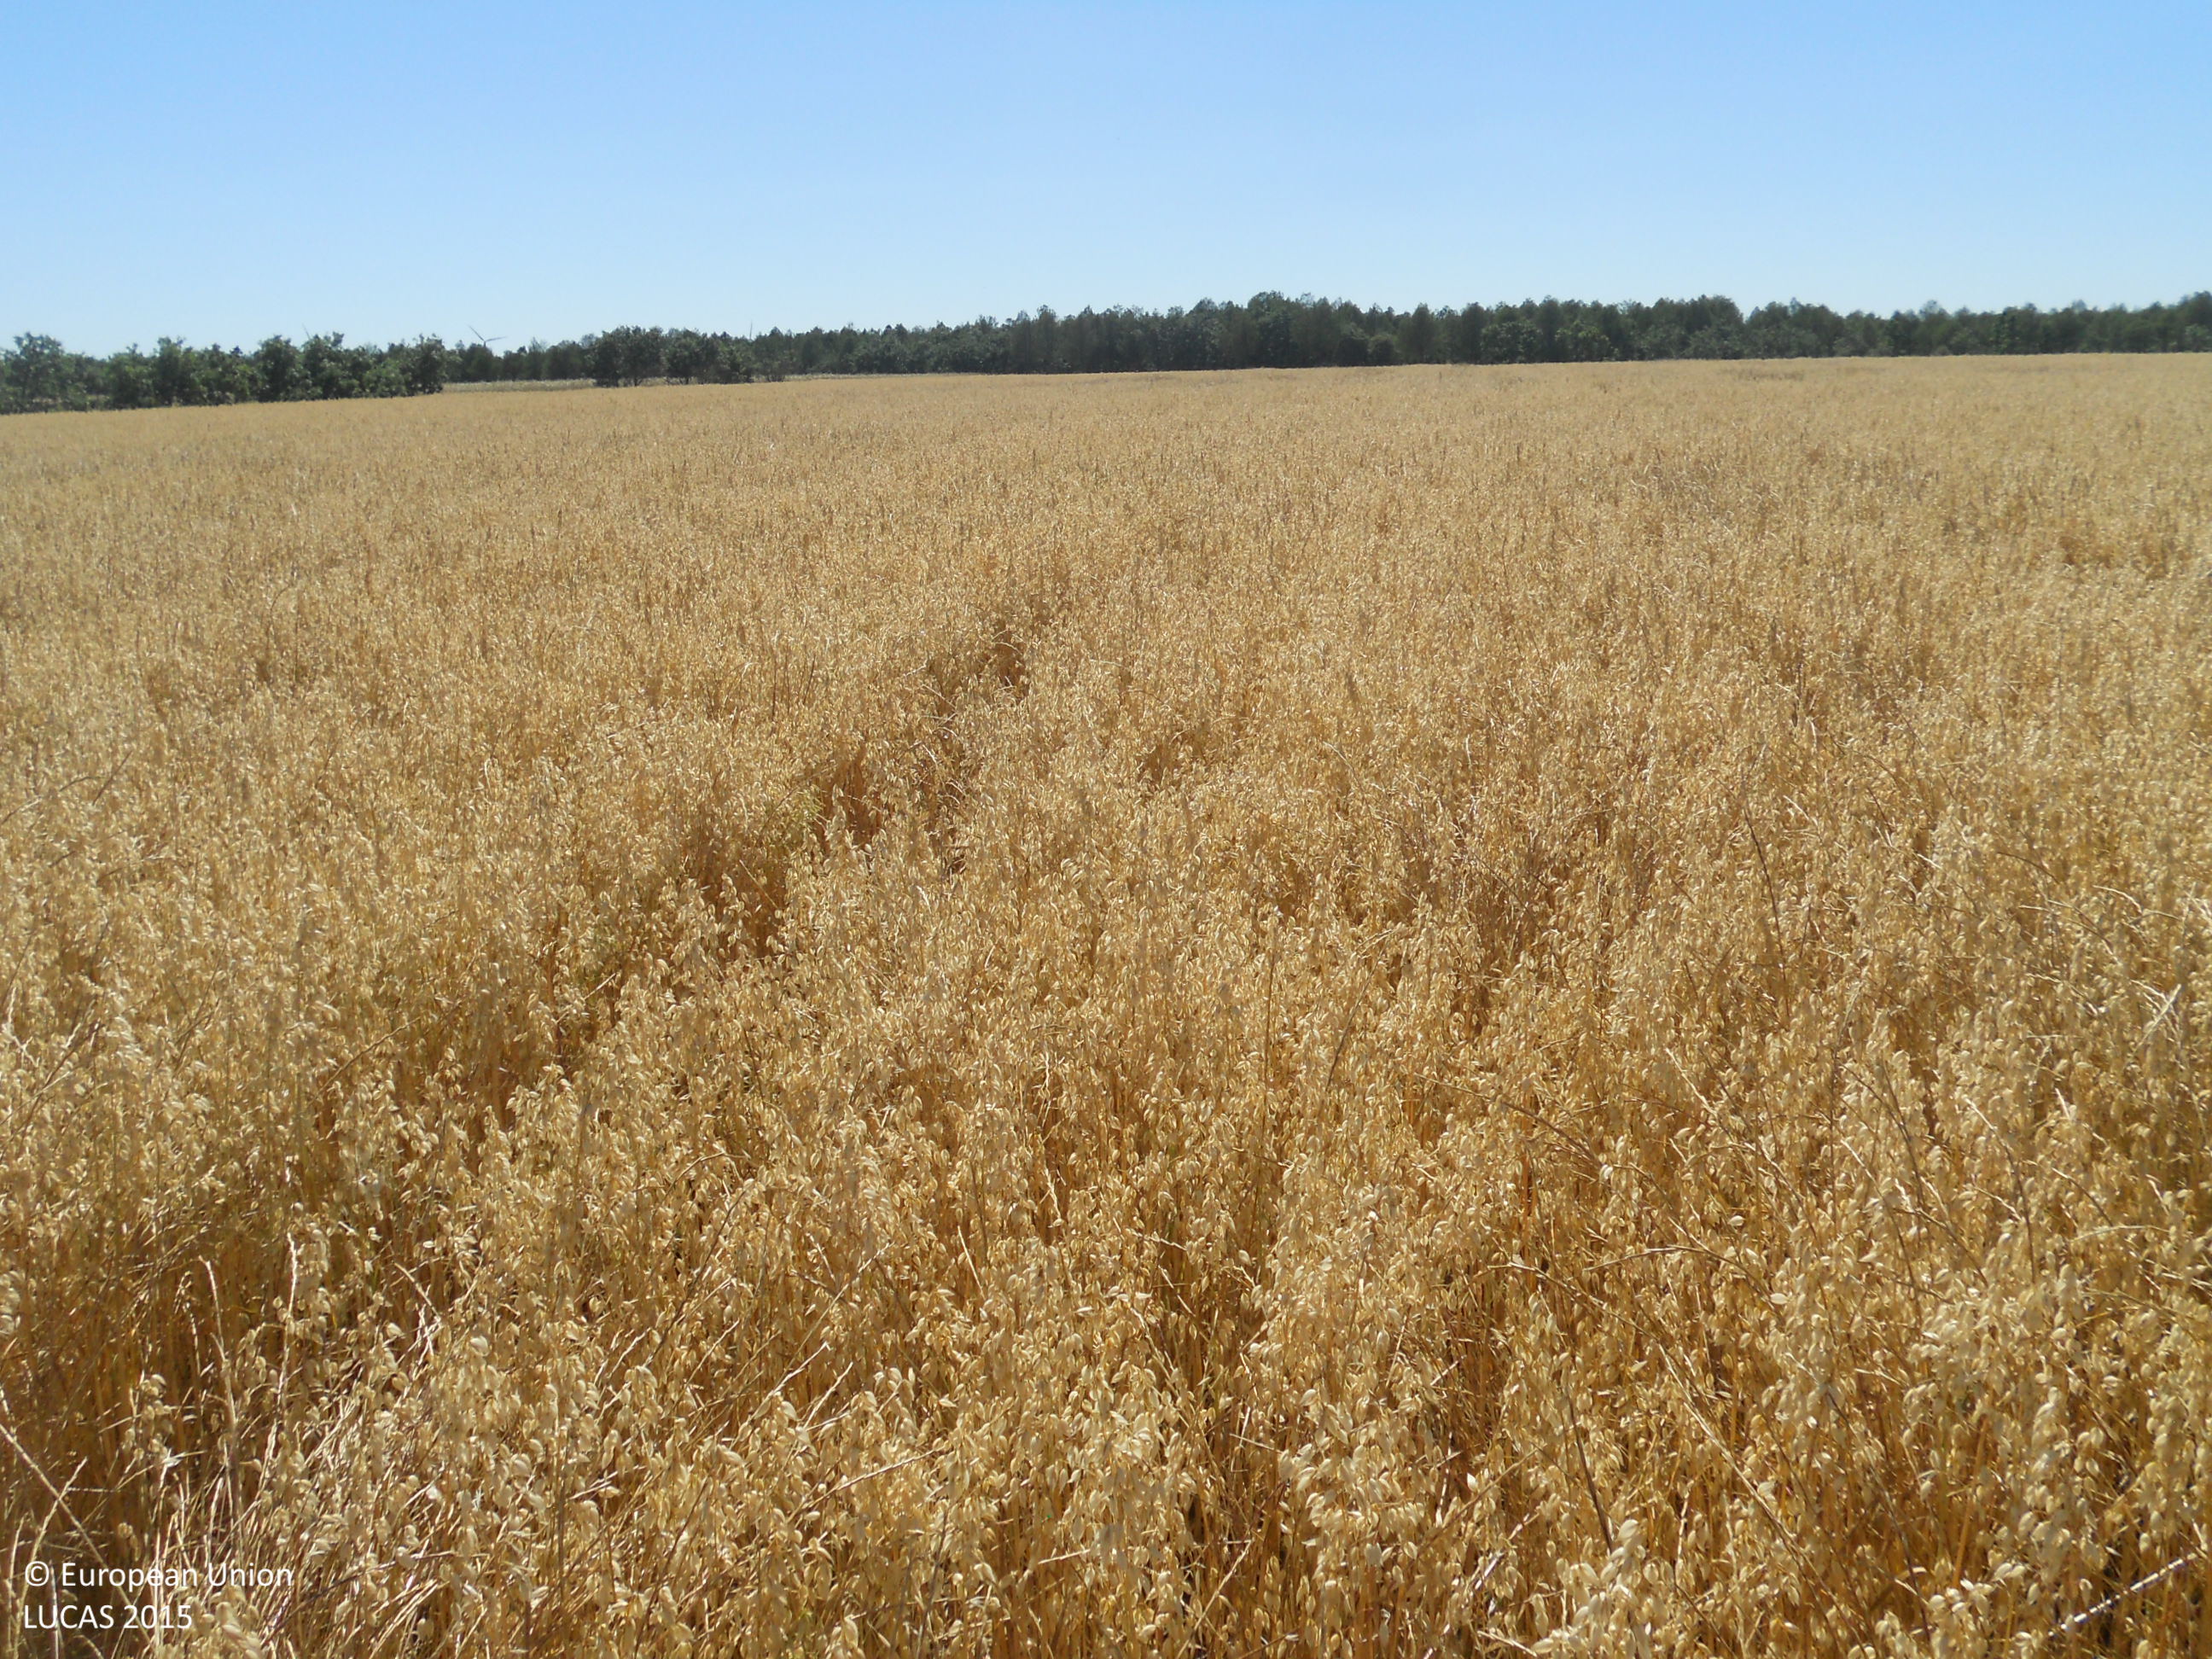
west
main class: Cropland
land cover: Oats
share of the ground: > 75 %
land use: Agriculture (excluding fallow land and kitchen gardens)
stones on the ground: > 50 %
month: June
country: ES
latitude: 42.4110
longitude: -4.8692
